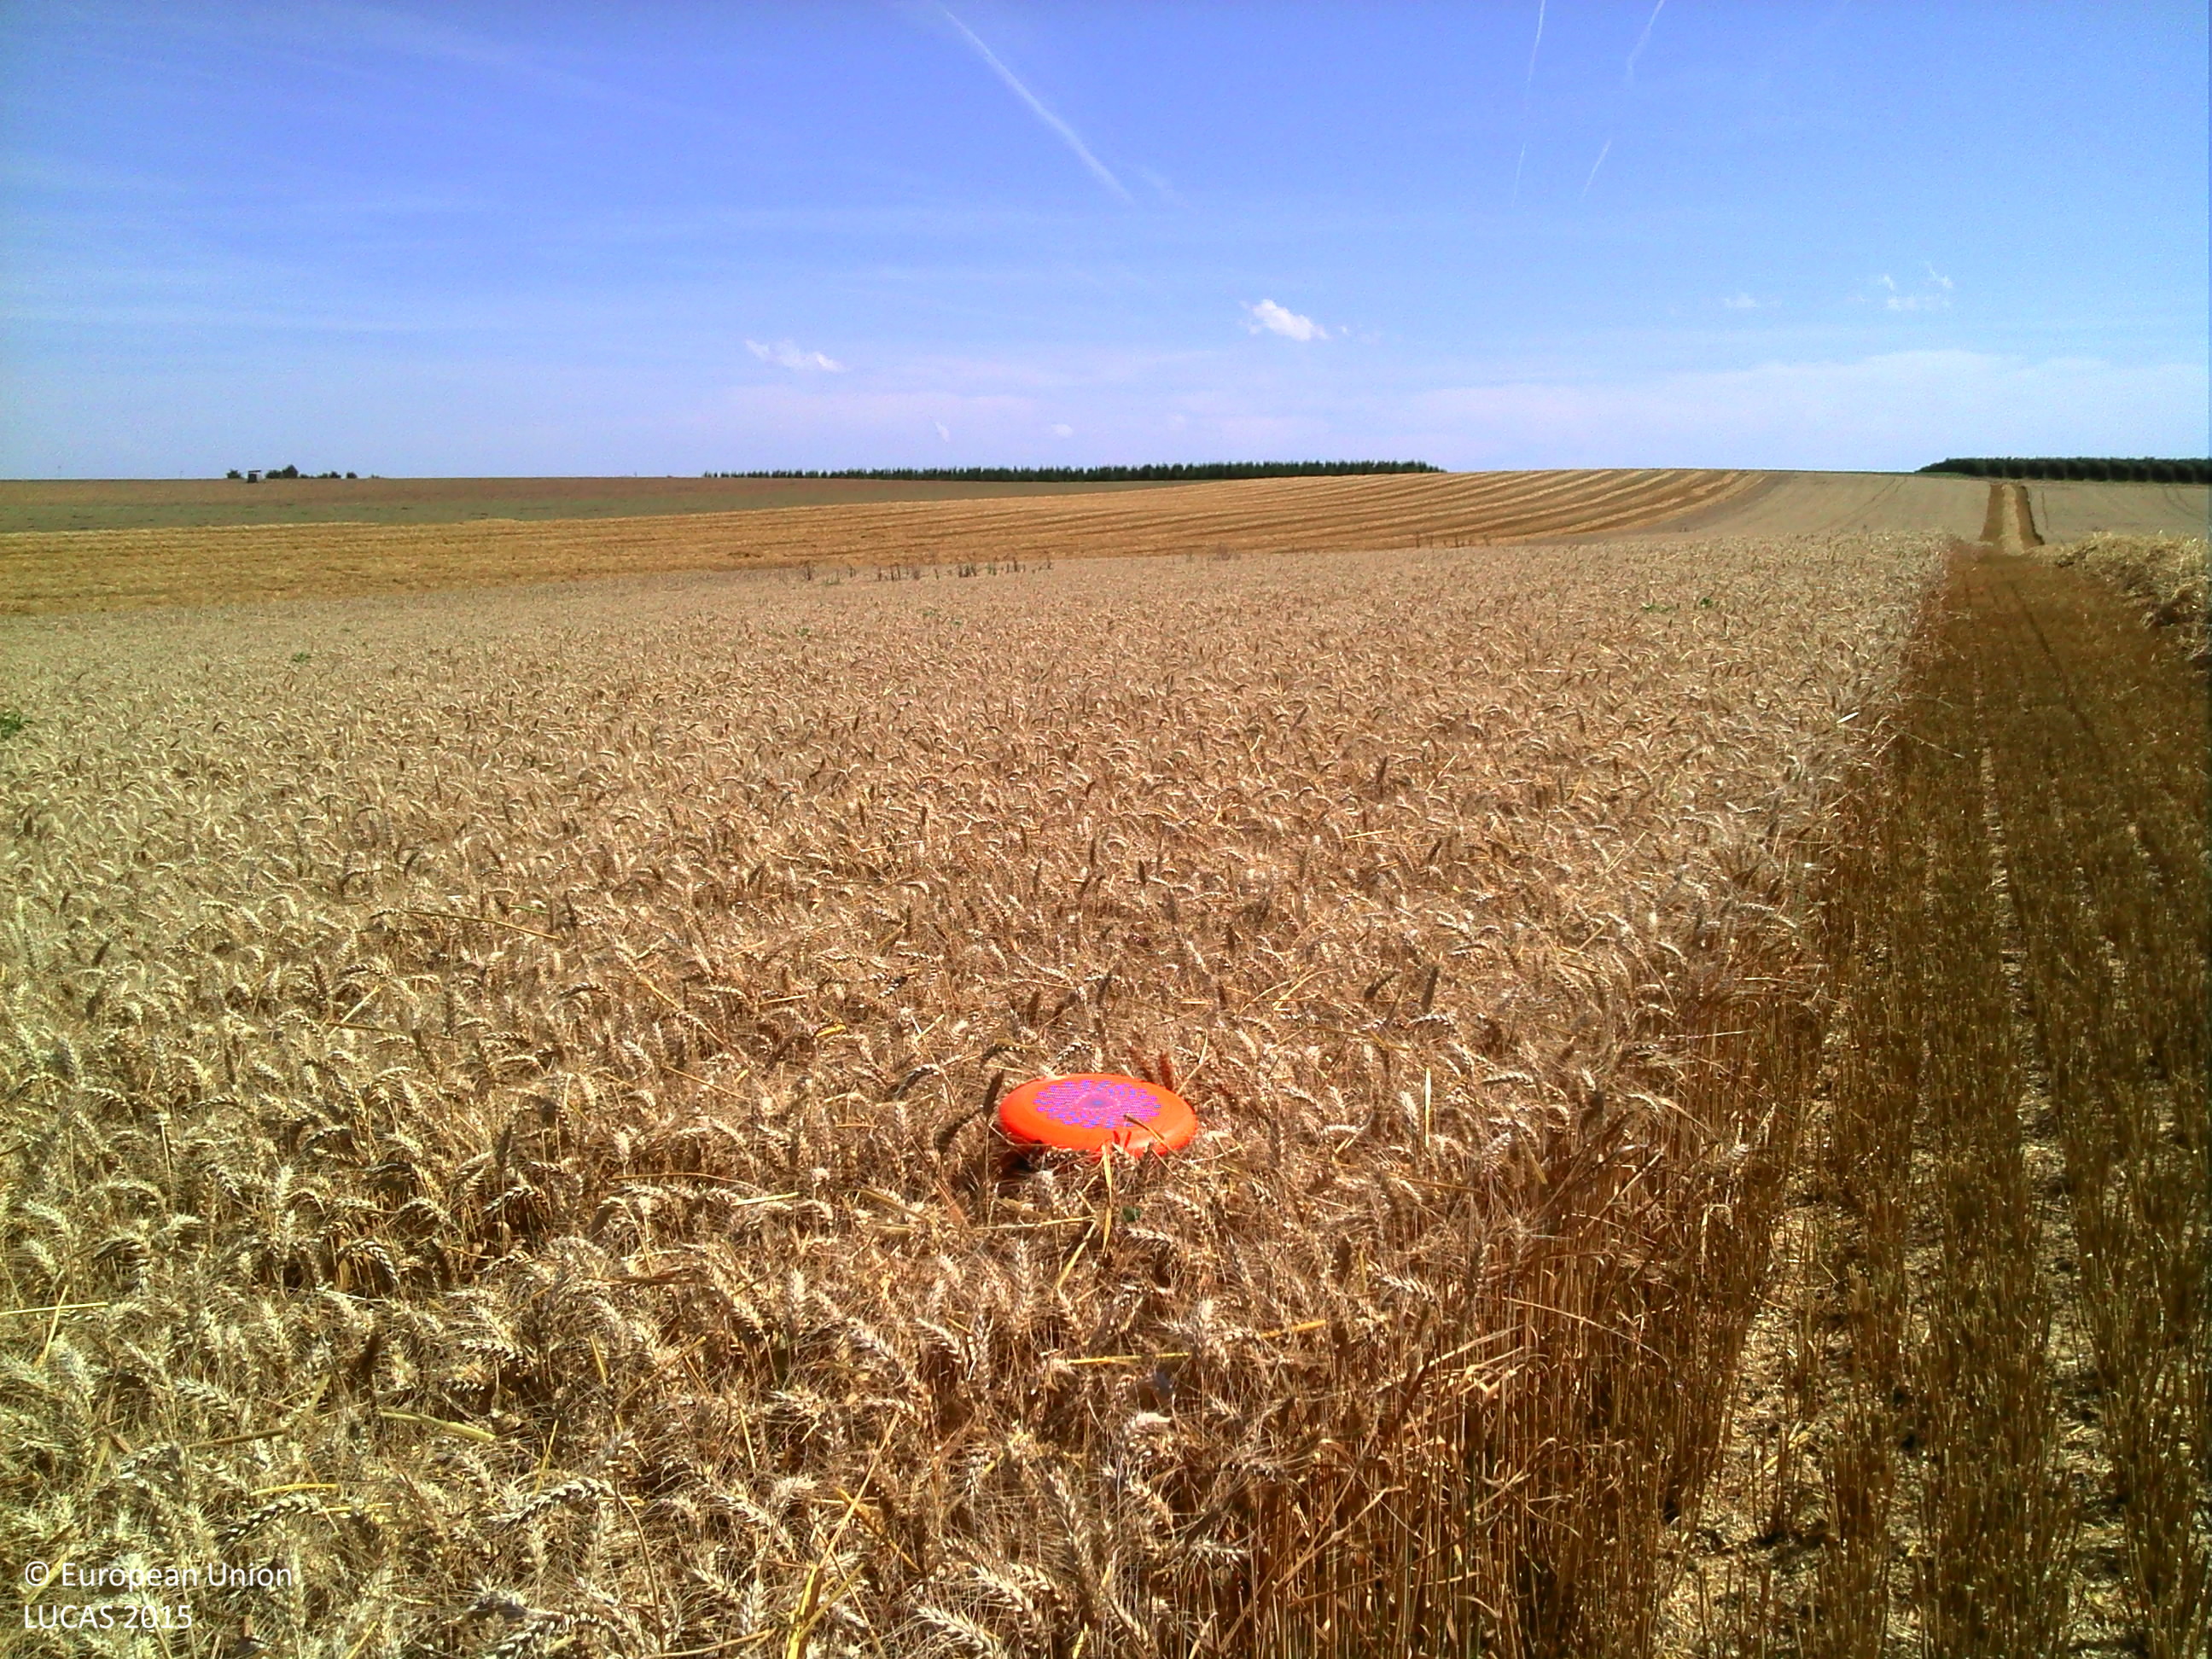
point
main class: Cropland
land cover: Common wheat
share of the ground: > 75 %
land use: Agriculture (excluding fallow land and kitchen gardens)
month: August
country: BE
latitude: 50.7350
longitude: 5.2795
